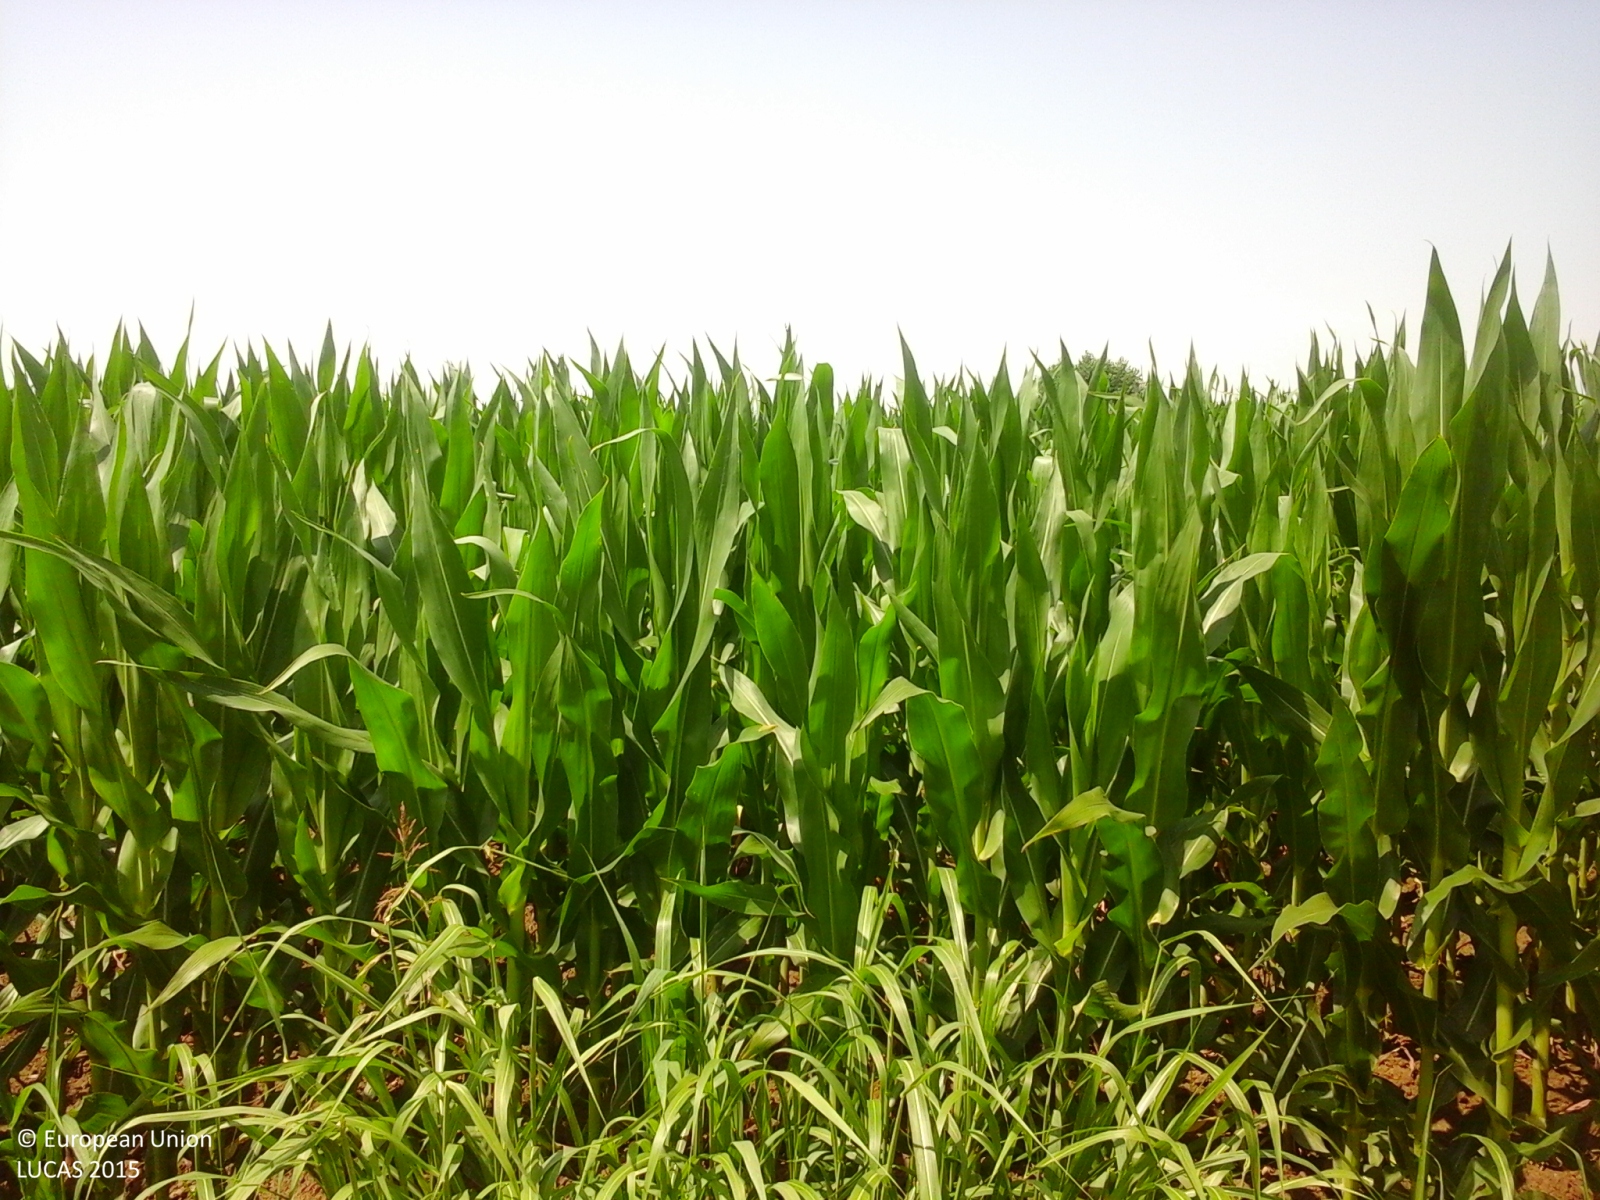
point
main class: Cropland
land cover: Maize
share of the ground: > 75 %
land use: Agriculture (excluding fallow land and kitchen gardens)
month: June
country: IT
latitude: 45.2463
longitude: 11.1064
